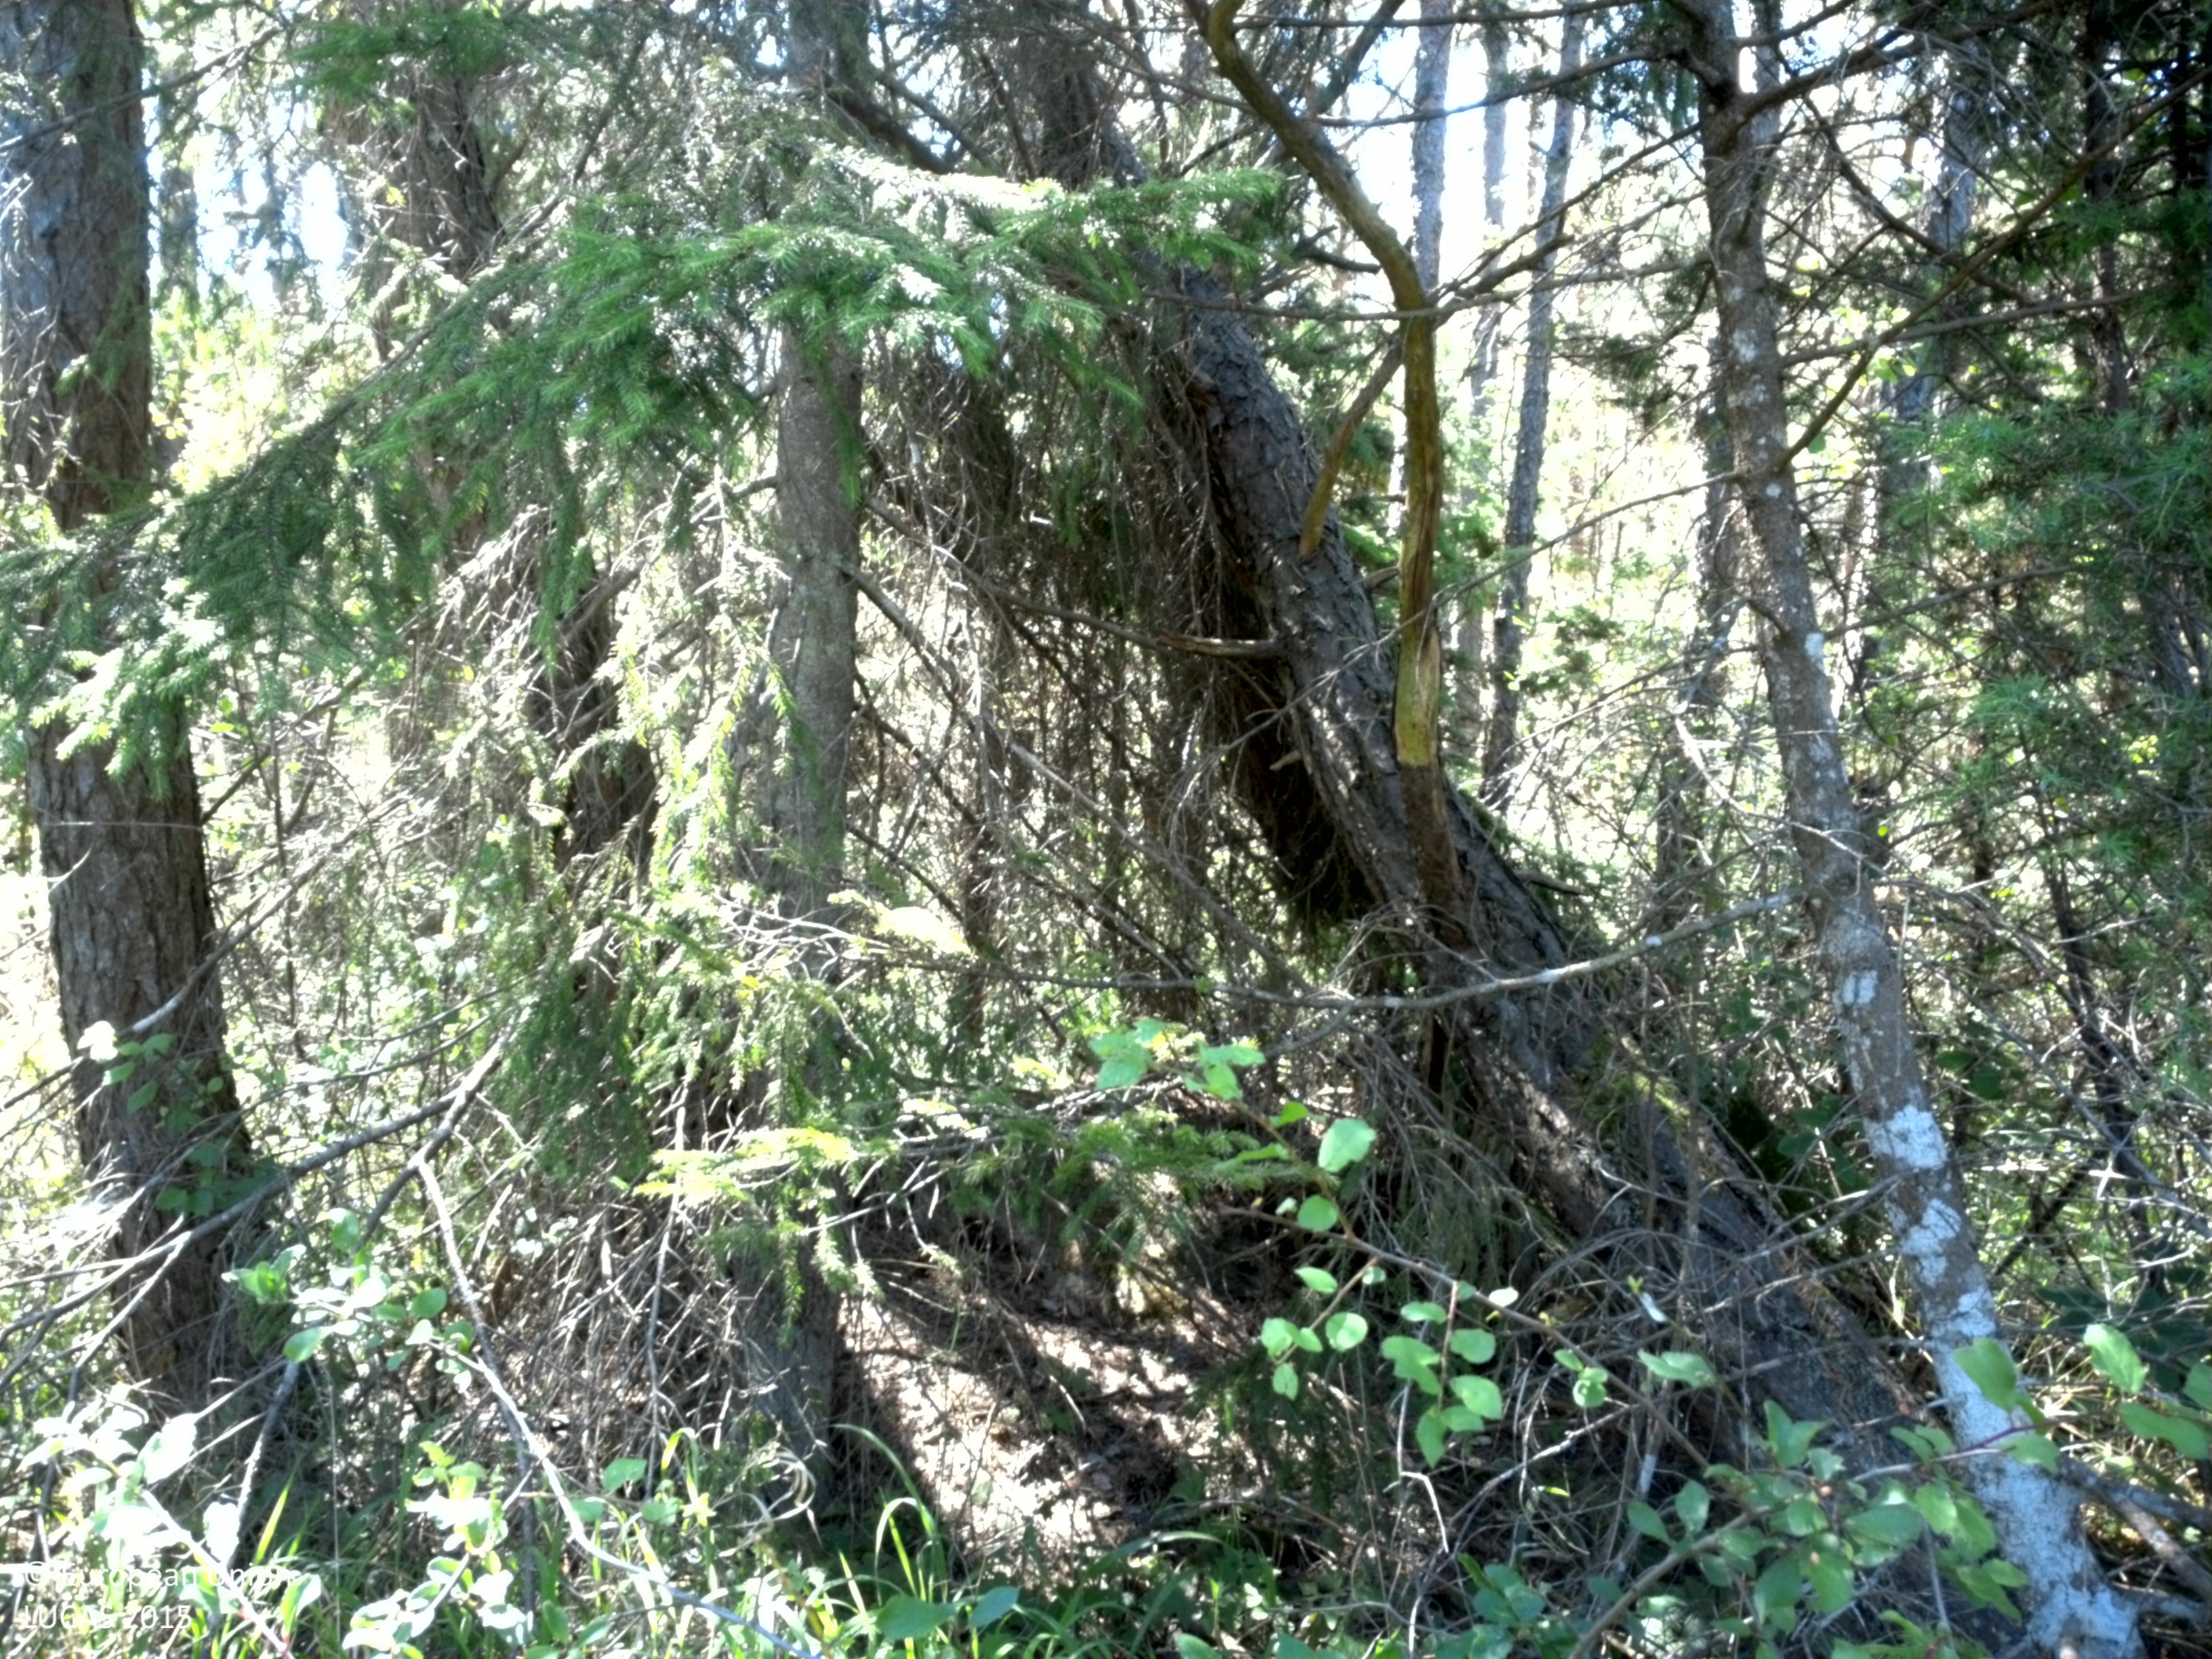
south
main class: Woodland
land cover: Pine dominated coniferous woodland
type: hemiboreal forest and nemoral coniferous forest and mixed broadleaved-coniferous forest
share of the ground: > 75 %
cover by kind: coniferous forest trees 70 %, herbaceous plants 15 %, shrubs 10 %, broadleaved forest trees 5 %
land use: Forestry
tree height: > 5 m
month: July
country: SE
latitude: 57.7341
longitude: 18.7597
